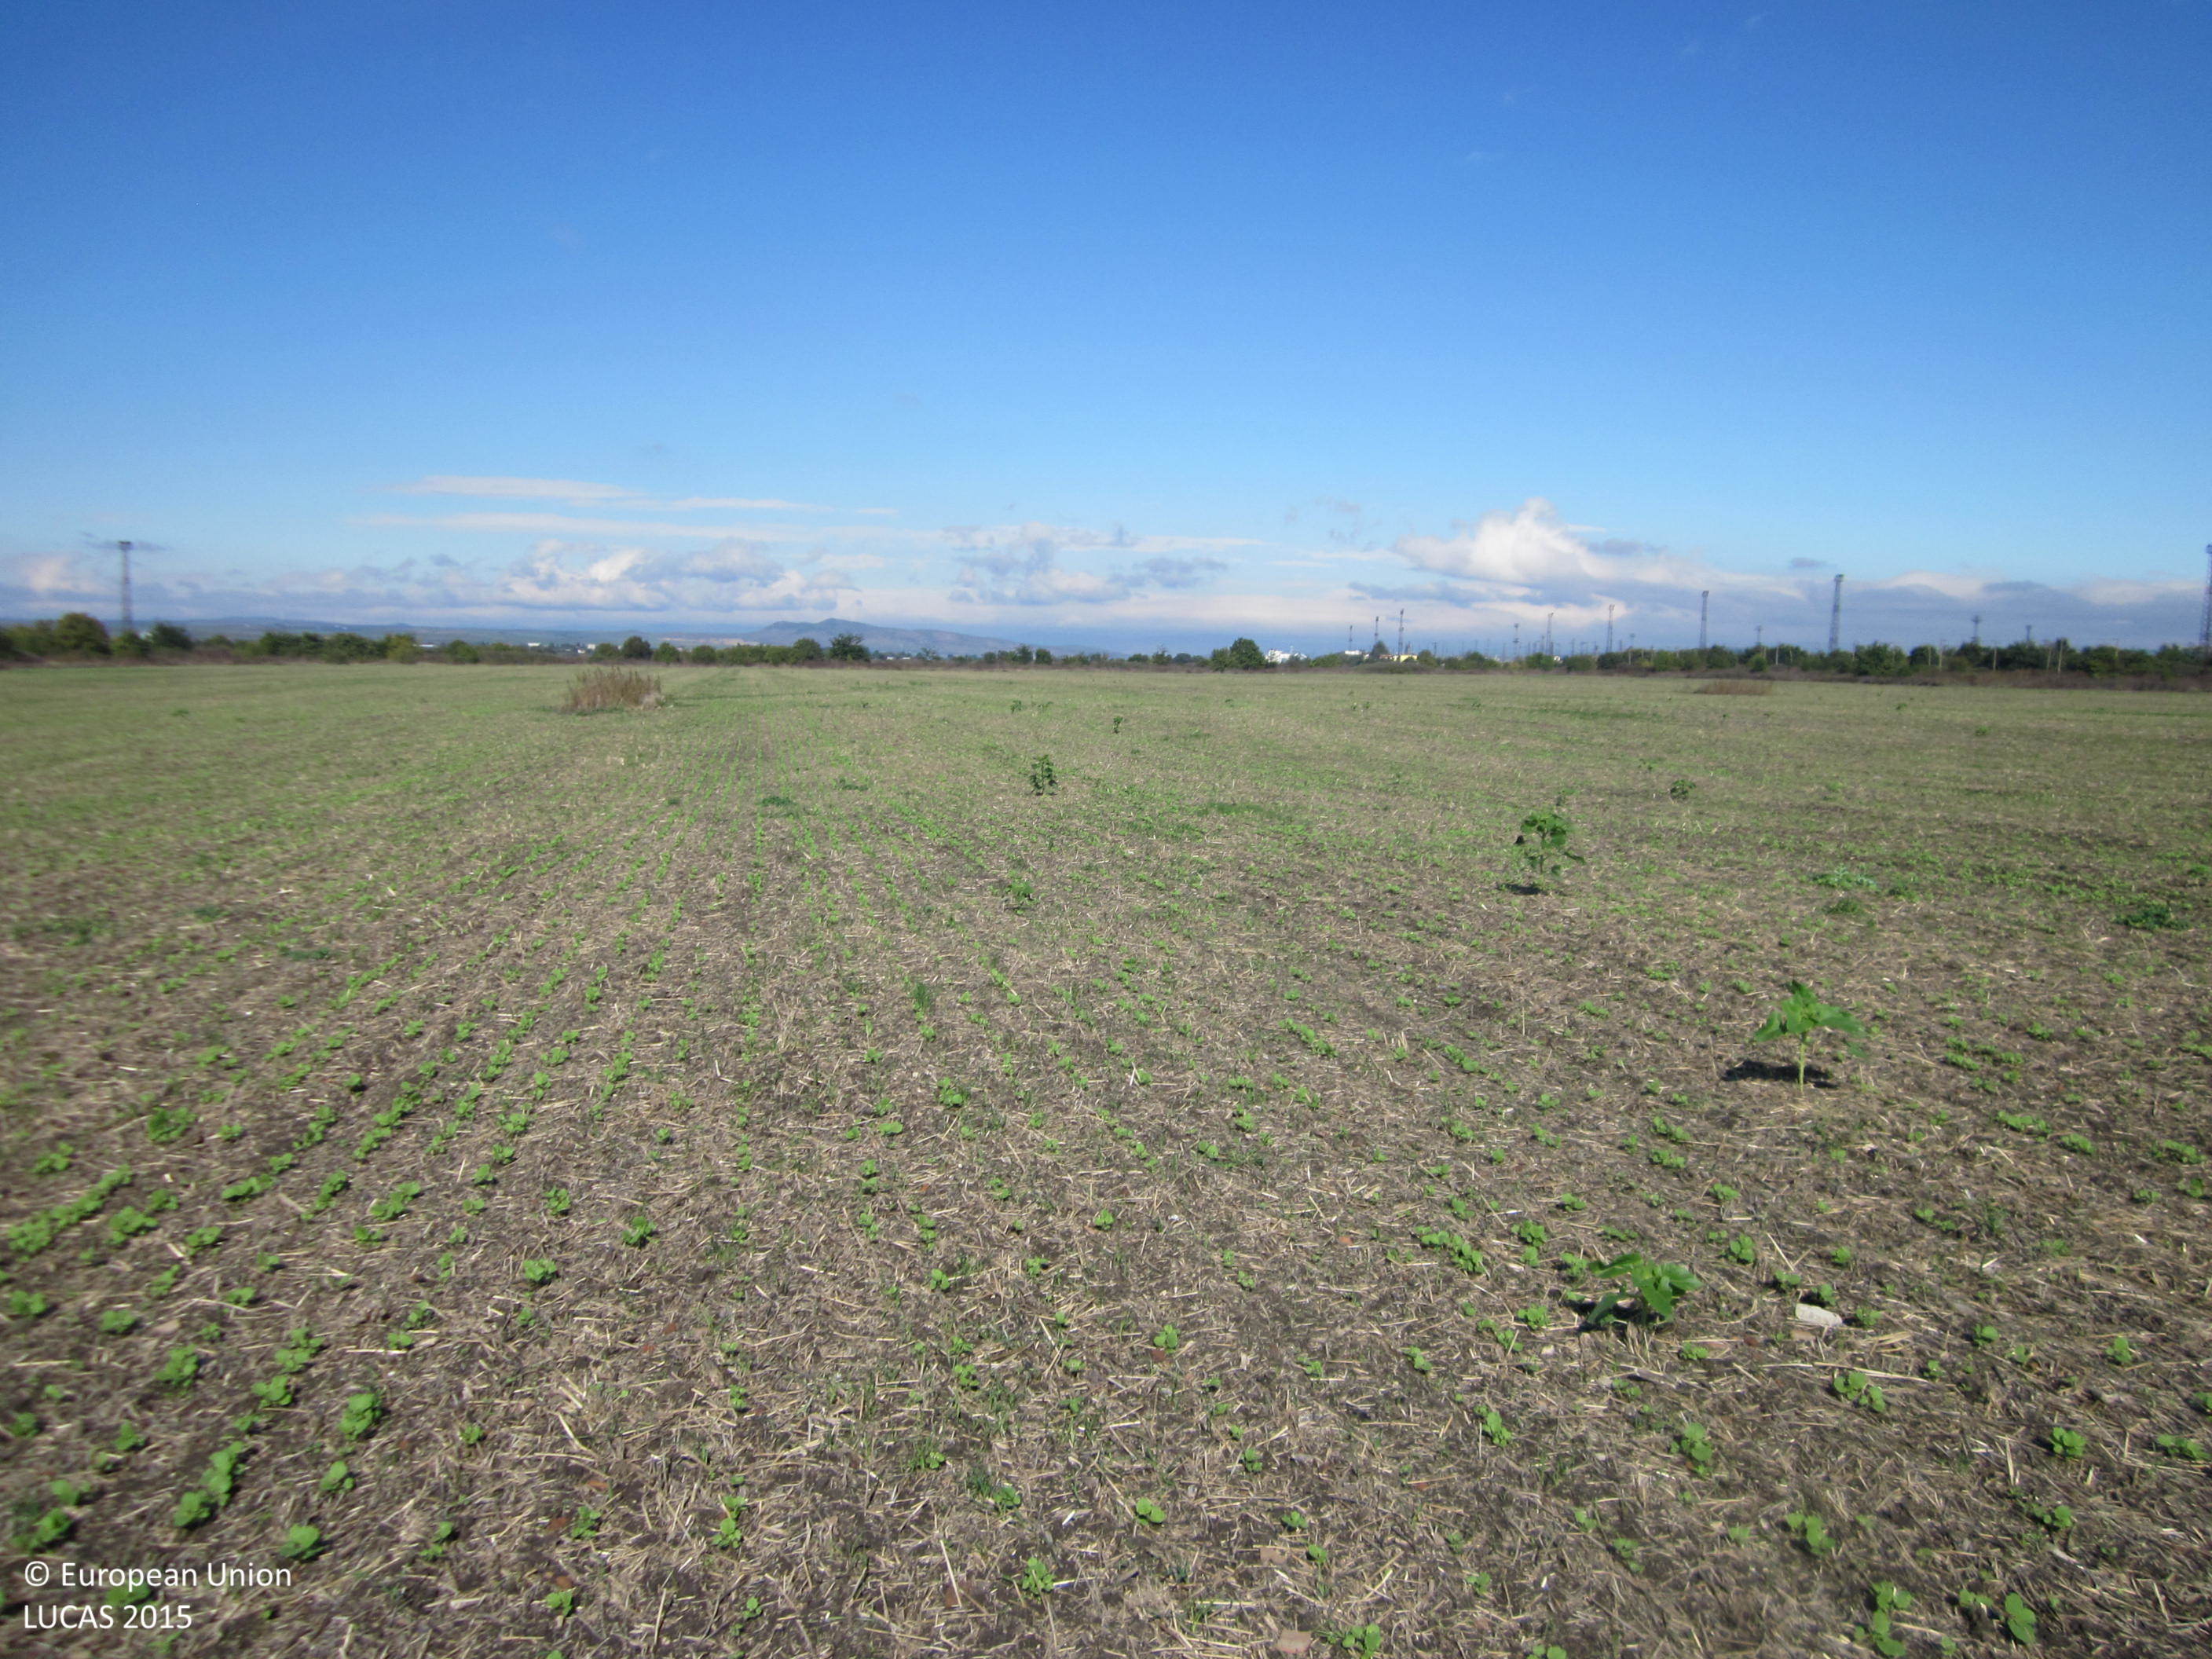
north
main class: Cropland
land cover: Common wheat
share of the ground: 10 - 25 %
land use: Agriculture (excluding fallow land and kitchen gardens)
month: October
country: BG
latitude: 42.5487
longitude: 27.3211
